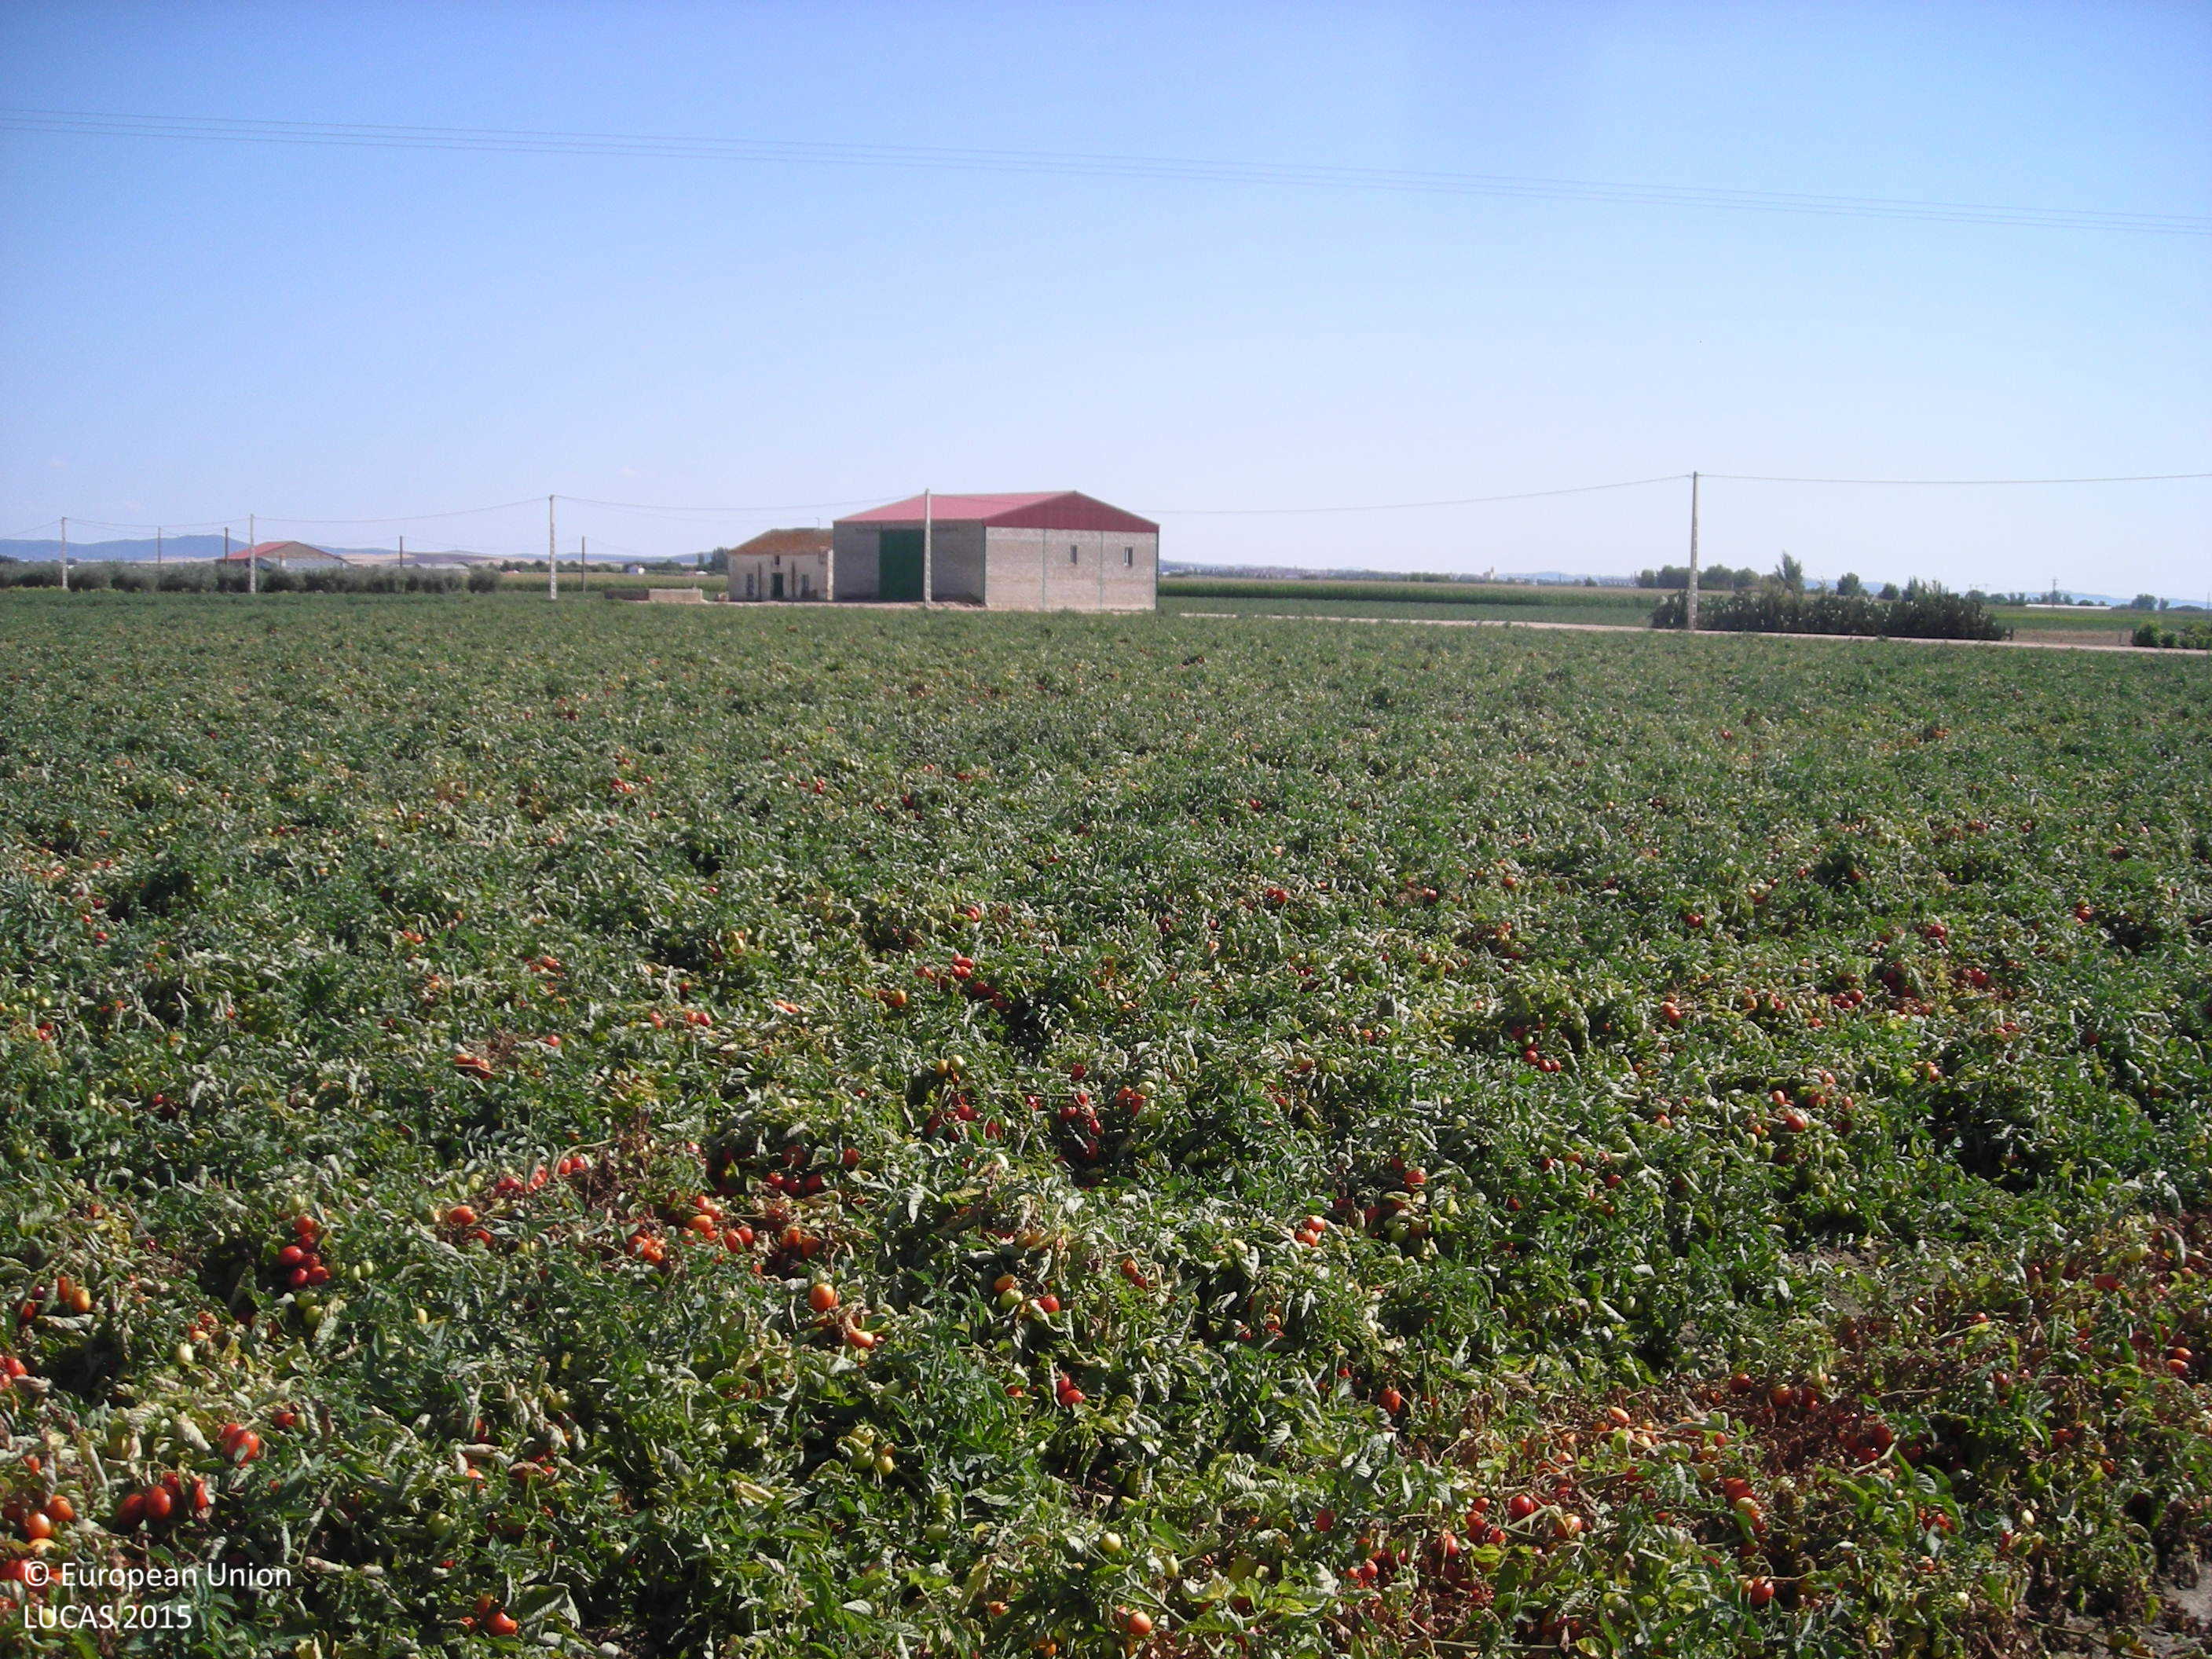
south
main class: Cropland
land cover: Tomatoes
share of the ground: > 75 %
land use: Agriculture (excluding fallow land and kitchen gardens)
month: July
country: ES
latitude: 39.0088
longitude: -5.8361
